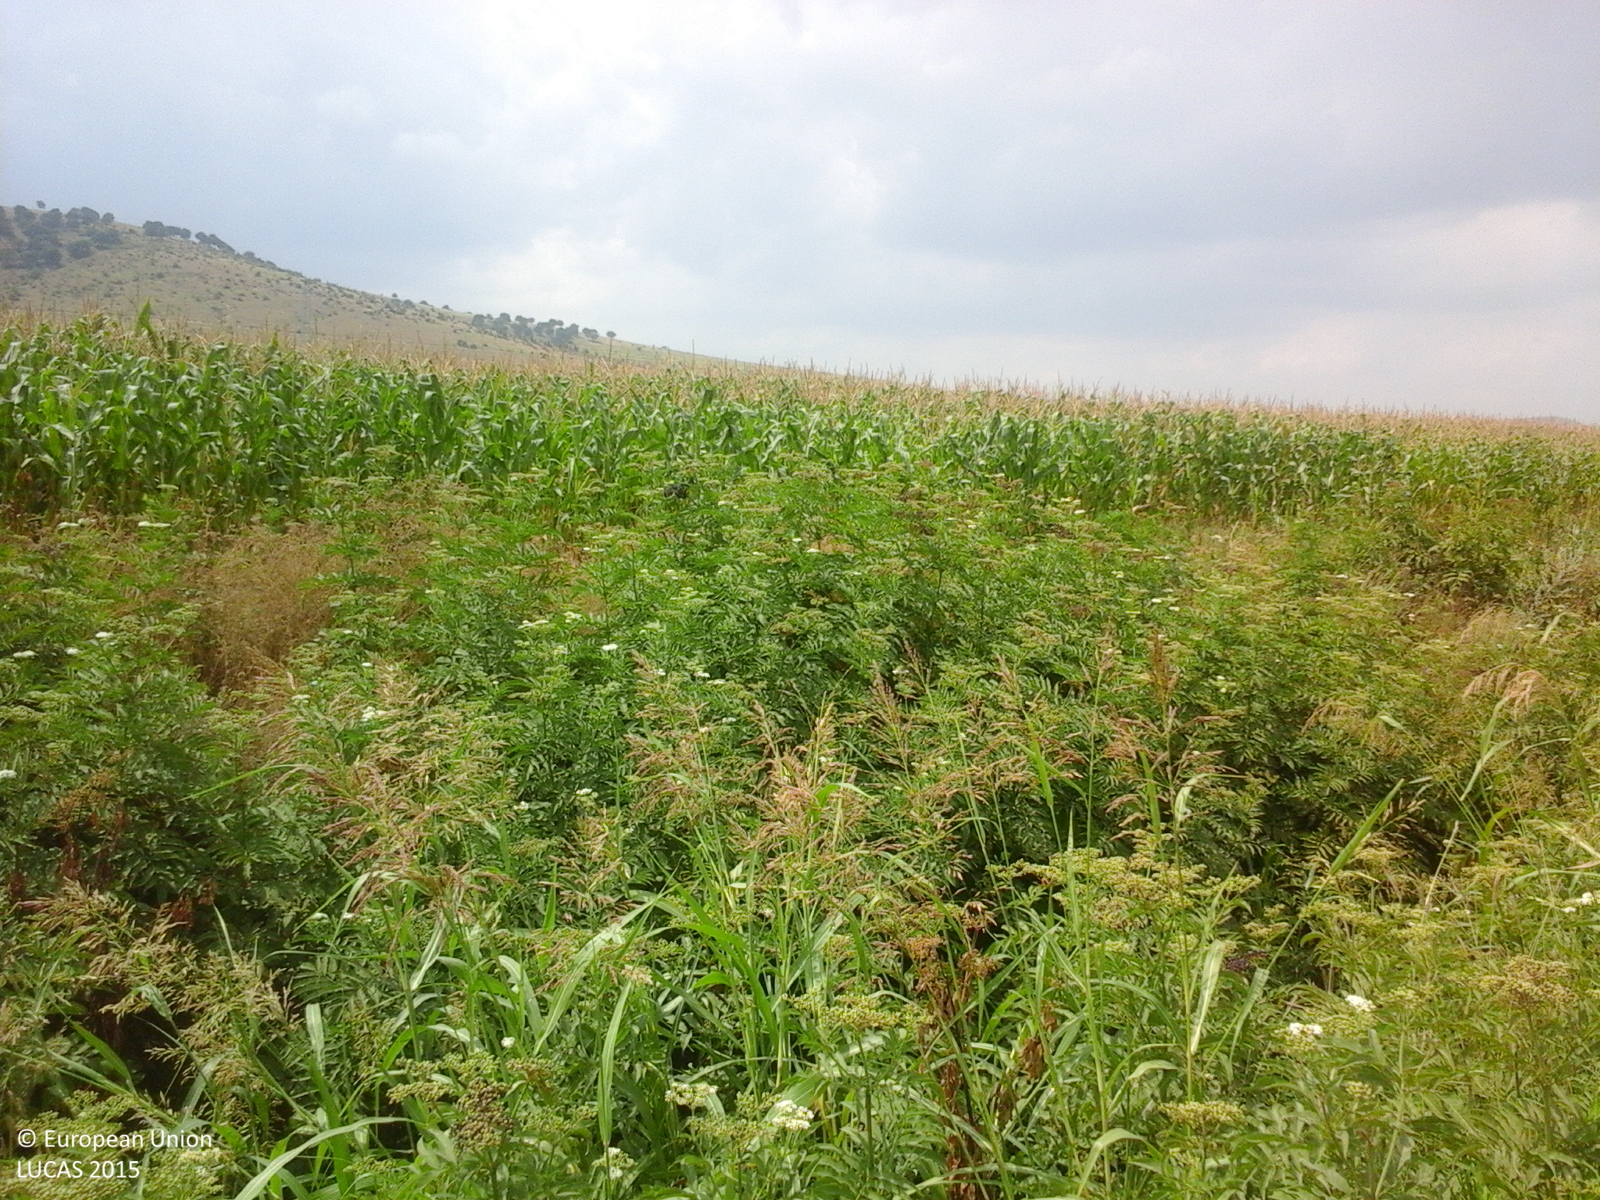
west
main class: Cropland
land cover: Maize
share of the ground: > 75 %
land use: Agriculture (excluding fallow land and kitchen gardens)
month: July
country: RO
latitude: 44.9546
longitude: 28.6267
